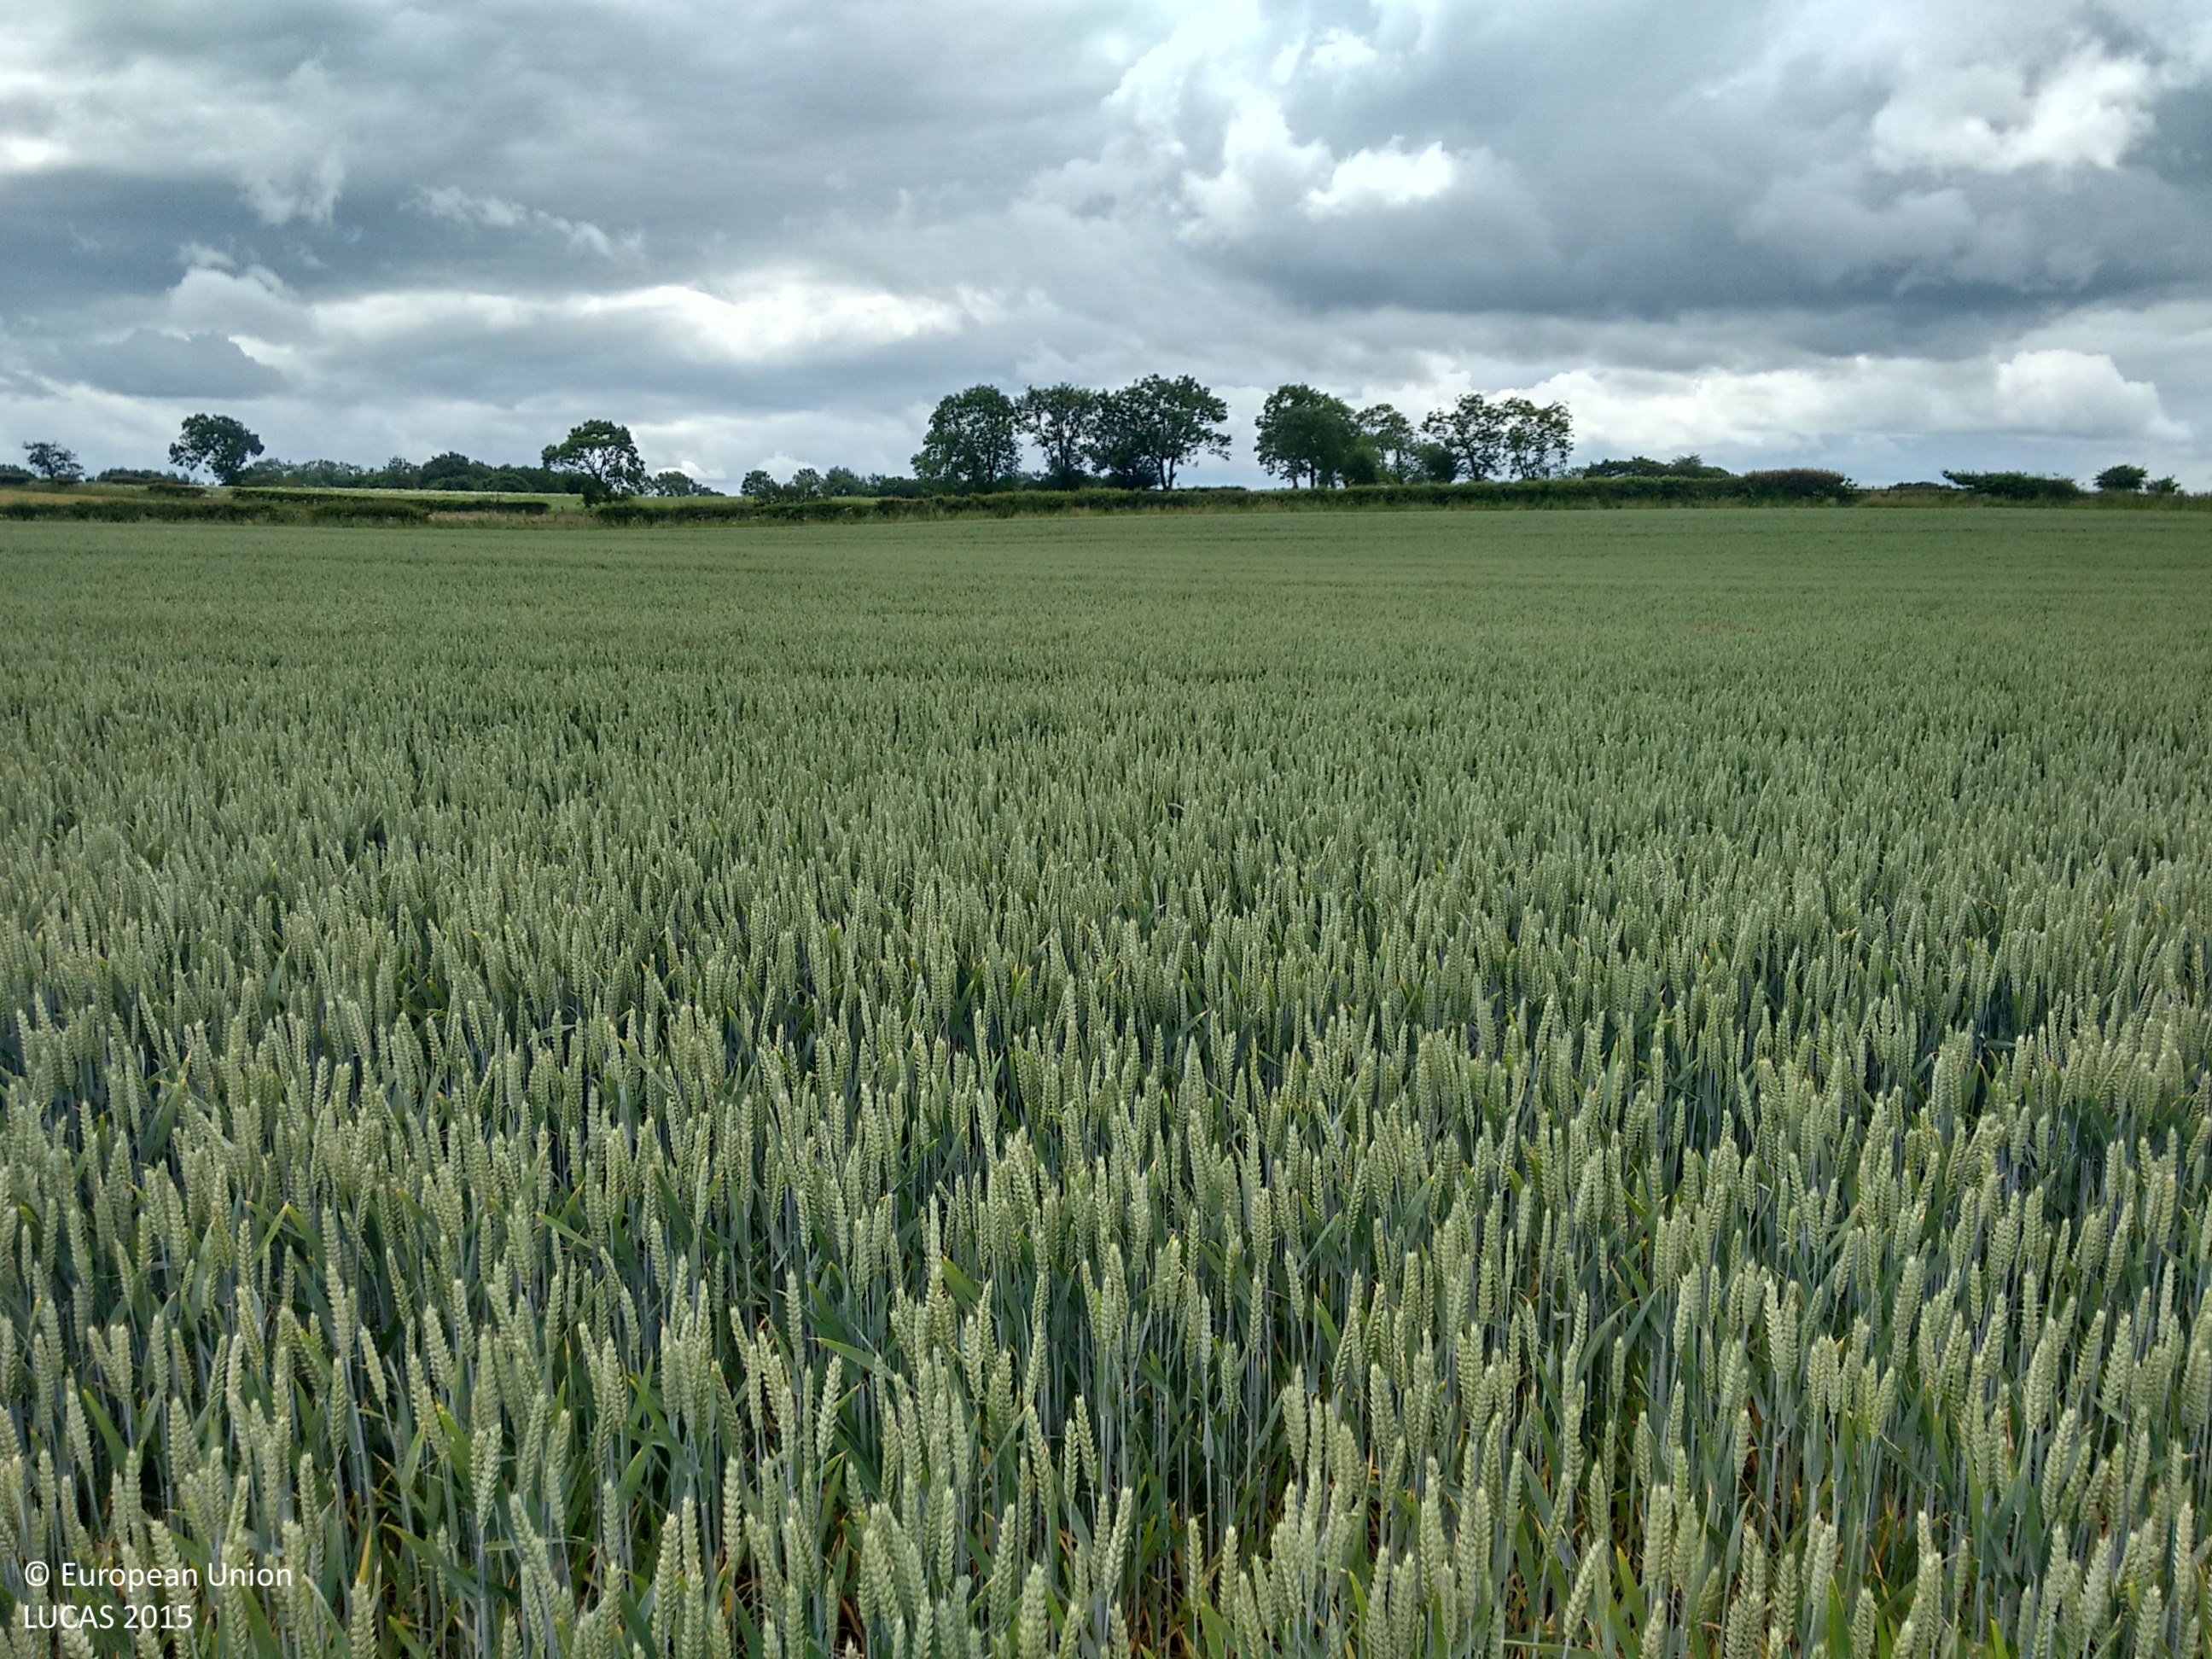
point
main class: Cropland
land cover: Barley
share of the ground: > 75 %
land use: Agriculture (excluding fallow land and kitchen gardens)
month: July
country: GB
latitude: 54.5947
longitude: -1.5171
